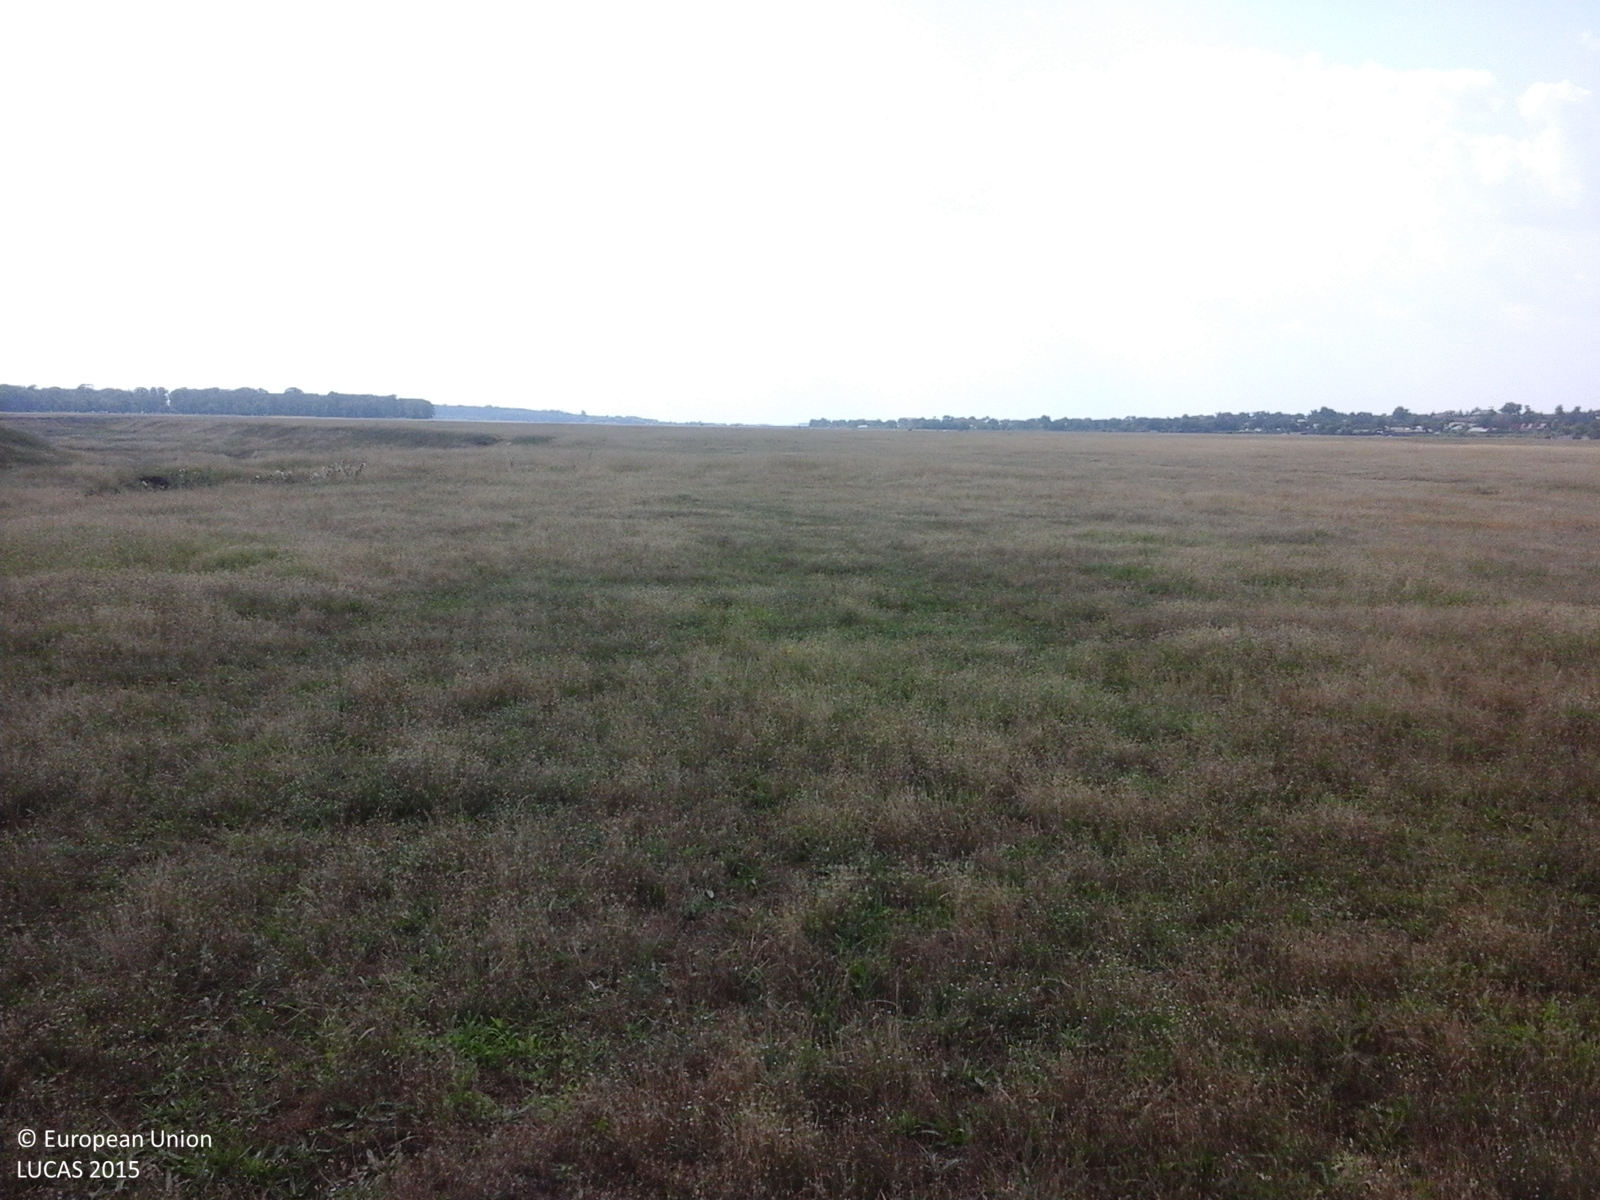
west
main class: Grassland
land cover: Grassland without tree/shrub cover
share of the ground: > 75 %
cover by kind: herbaceous plants 100 %
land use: Agriculture (excluding fallow land and kitchen gardens)
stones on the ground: < 10 %
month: July
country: RO
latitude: 44.0272
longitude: 25.2151
